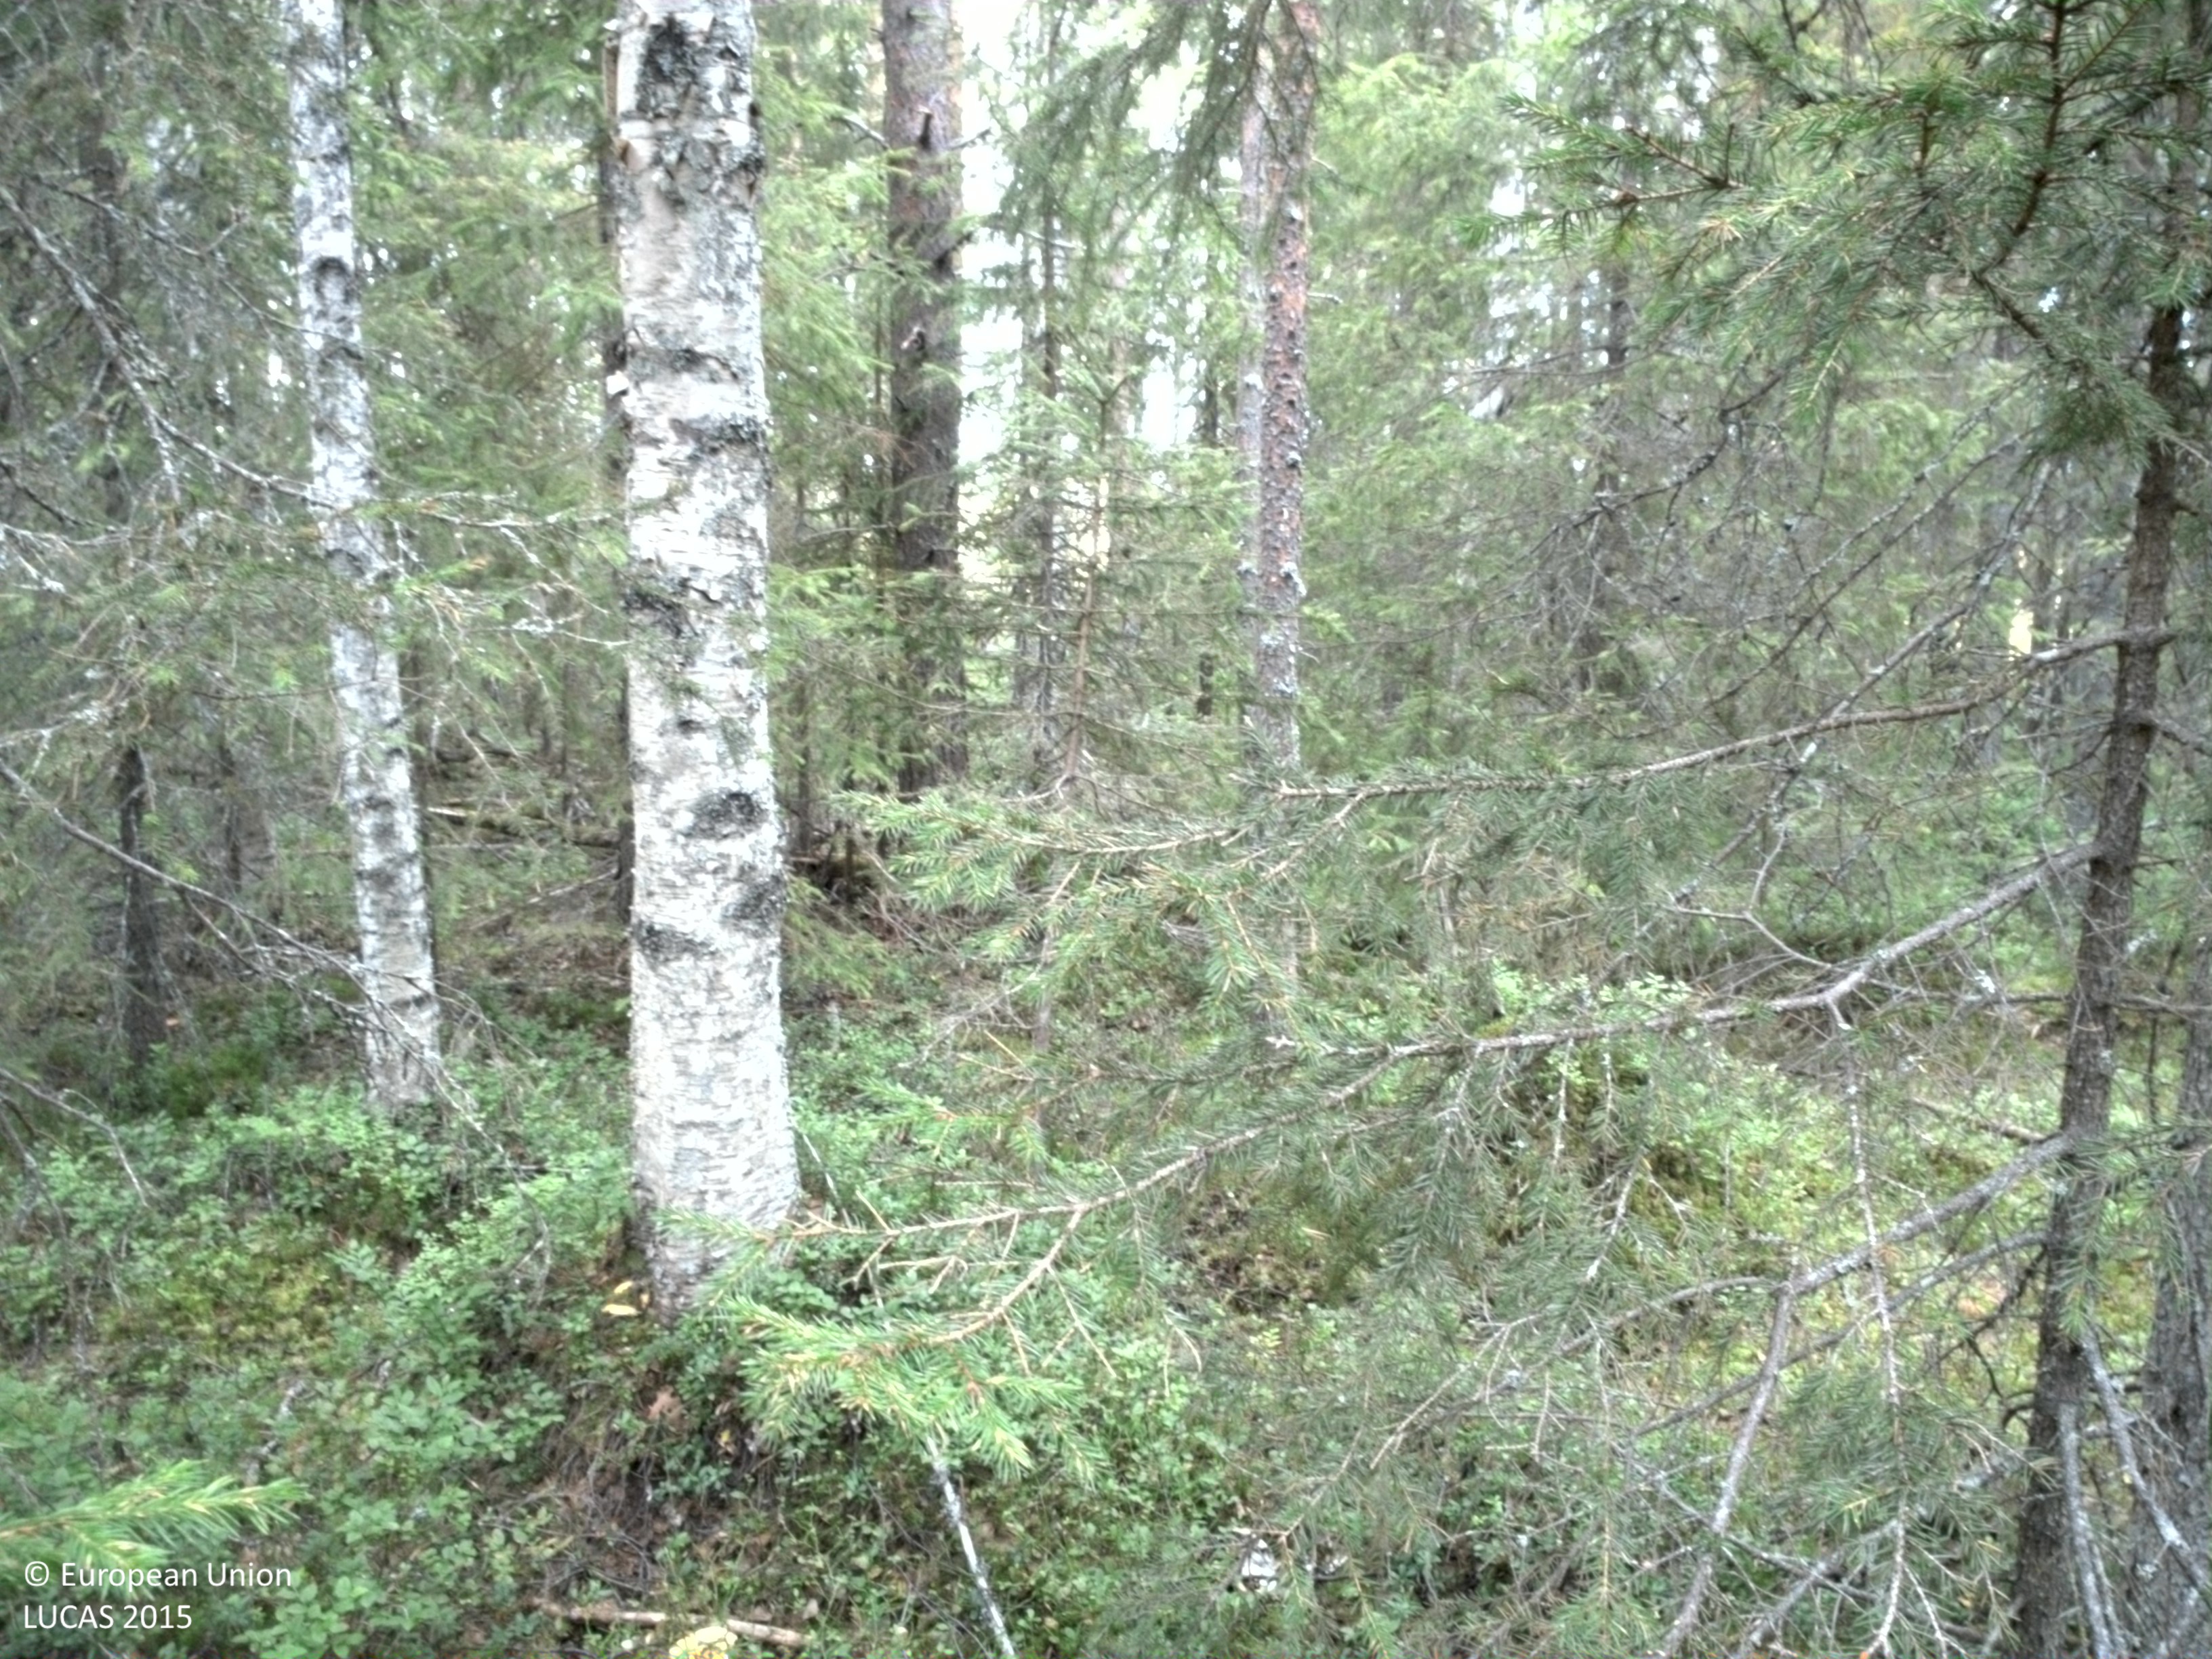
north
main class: Woodland
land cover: Other coniferous woodland
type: boreal forest
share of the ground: 25 - 50 %
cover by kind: shrubs 60 %, coniferous forest trees 40 %
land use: Forestry
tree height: > 5 m
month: August
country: SE
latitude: 66.2100
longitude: 22.7976
